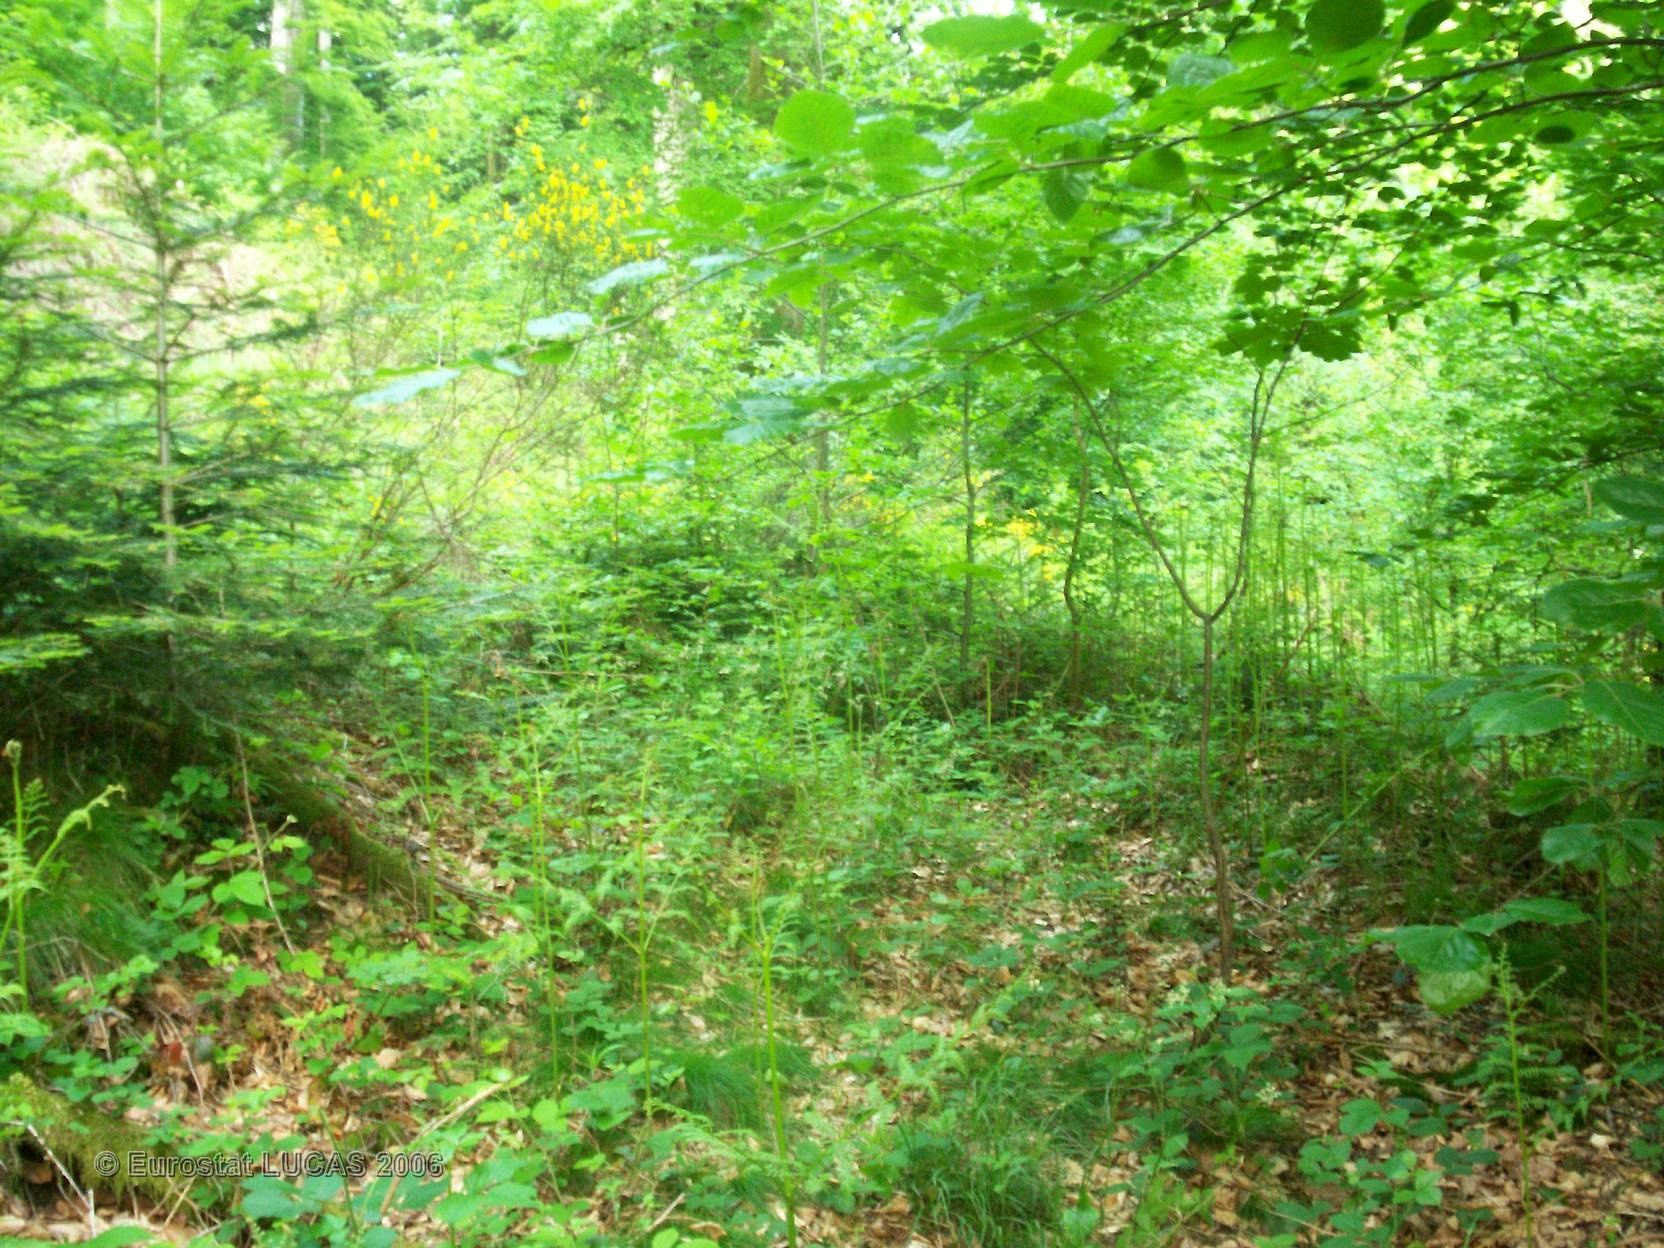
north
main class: Woodland
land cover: Mixed forest
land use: Forestry
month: June
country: FR
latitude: 48.4891
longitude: 7.0104
